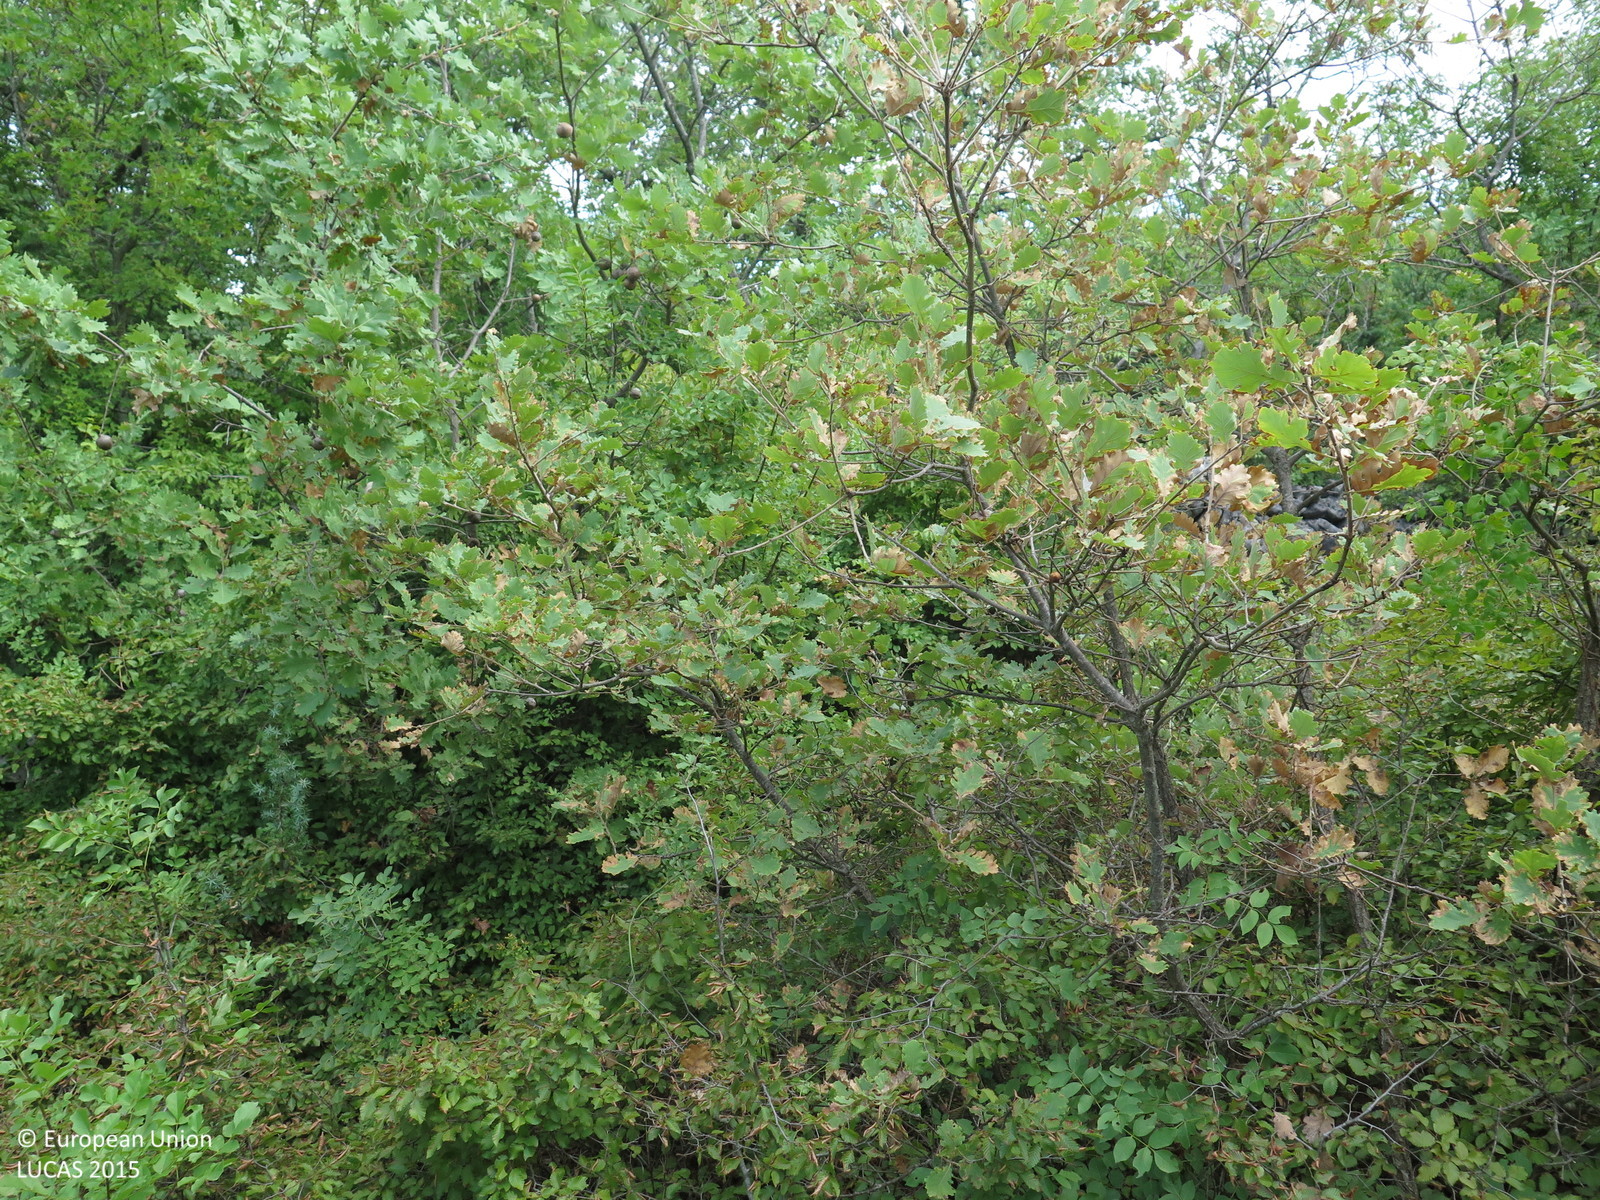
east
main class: Shrubland
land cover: Shrubland with sparse tree cover
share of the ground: > 75 %
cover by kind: shrubs 90 %, broadleaved forest trees 5 %, herbaceous plants 5 %
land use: Semi-natural and natural areas not in use
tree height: < 5 m
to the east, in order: Shrubland with sparse tree cover; Dry stone walls; Broadleaved woodland; Rocks and stones; Broadleaved woodland; Artificial constructions in urban areas
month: August
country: HR
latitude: 45.0463
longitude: 14.5268
